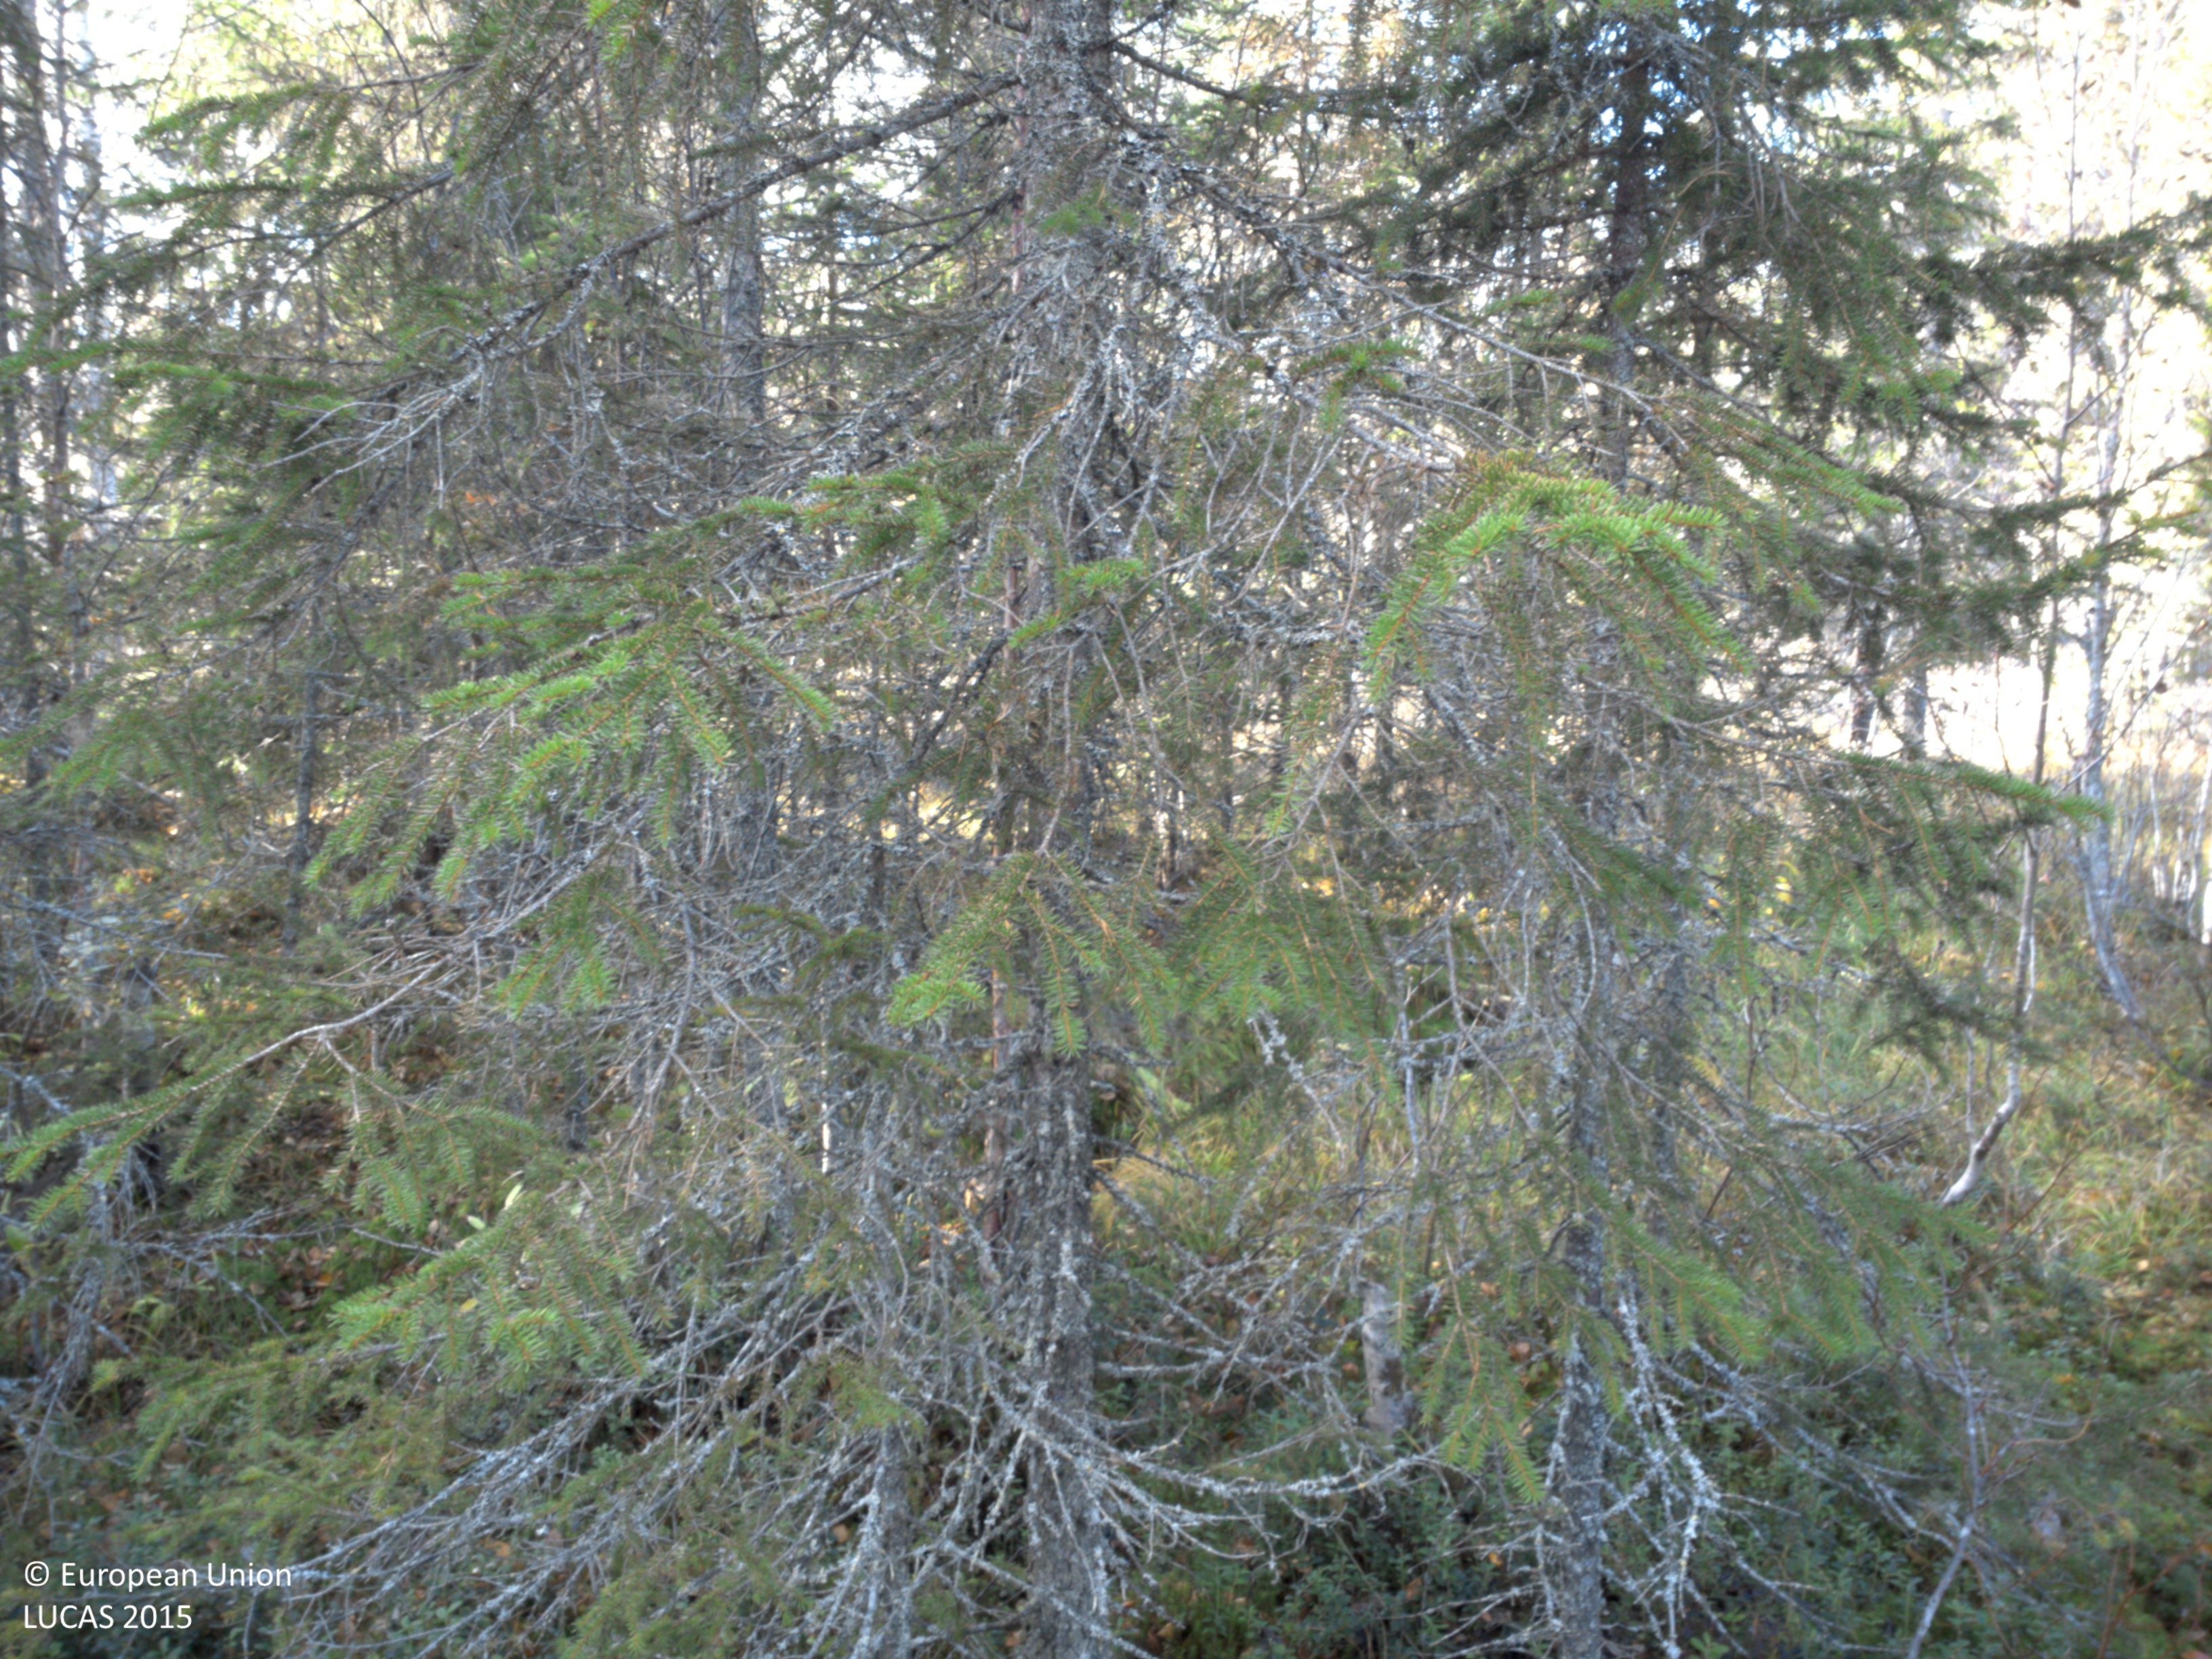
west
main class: Woodland
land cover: Other mixed woodland
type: boreal forest
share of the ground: 50 - 75 %
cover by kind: coniferous forest trees 45 %, shrubs 35 %, broadleaved forest trees 15 %, herbaceous plants 5 %
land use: Forestry
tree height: > 5 m
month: October
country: SE
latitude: 64.6312
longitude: 18.0203
